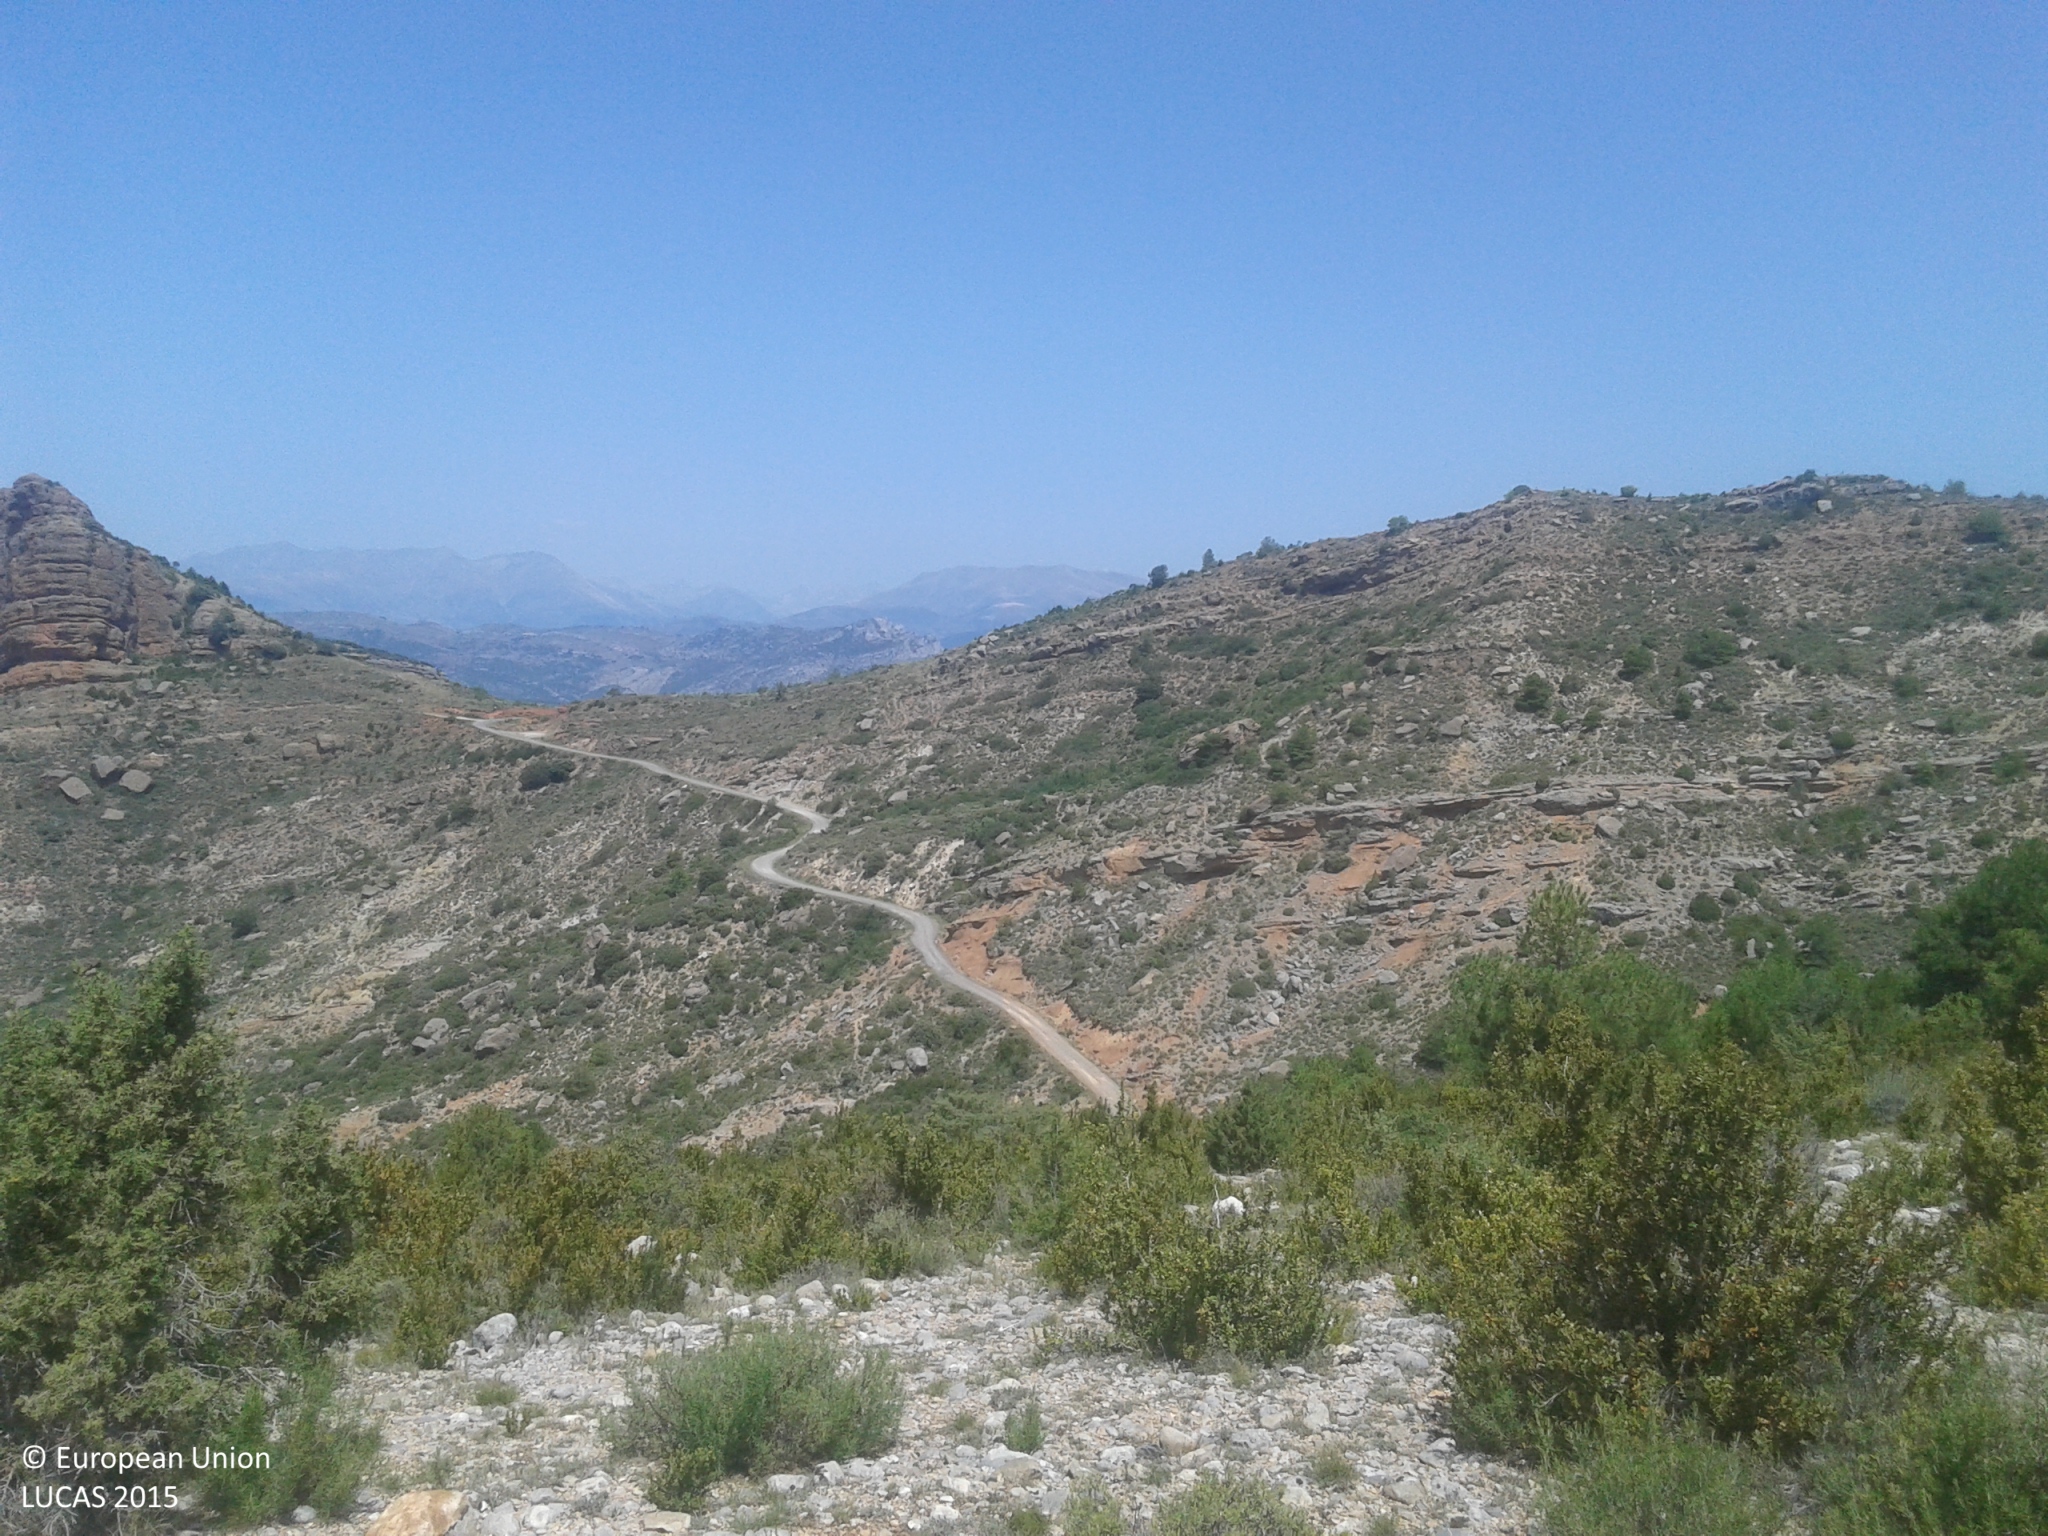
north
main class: Shrubland
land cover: Shrubland with sparse tree cover
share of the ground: 50 - 75 %
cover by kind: shrubs 60 %, consolidated bare surface 30 %, coniferous forest trees 5 %, herbaceous plants 5 %
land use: Semi-natural and natural areas not in use
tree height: < 5 m
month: August
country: ES
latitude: 42.2192
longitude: 1.0324
